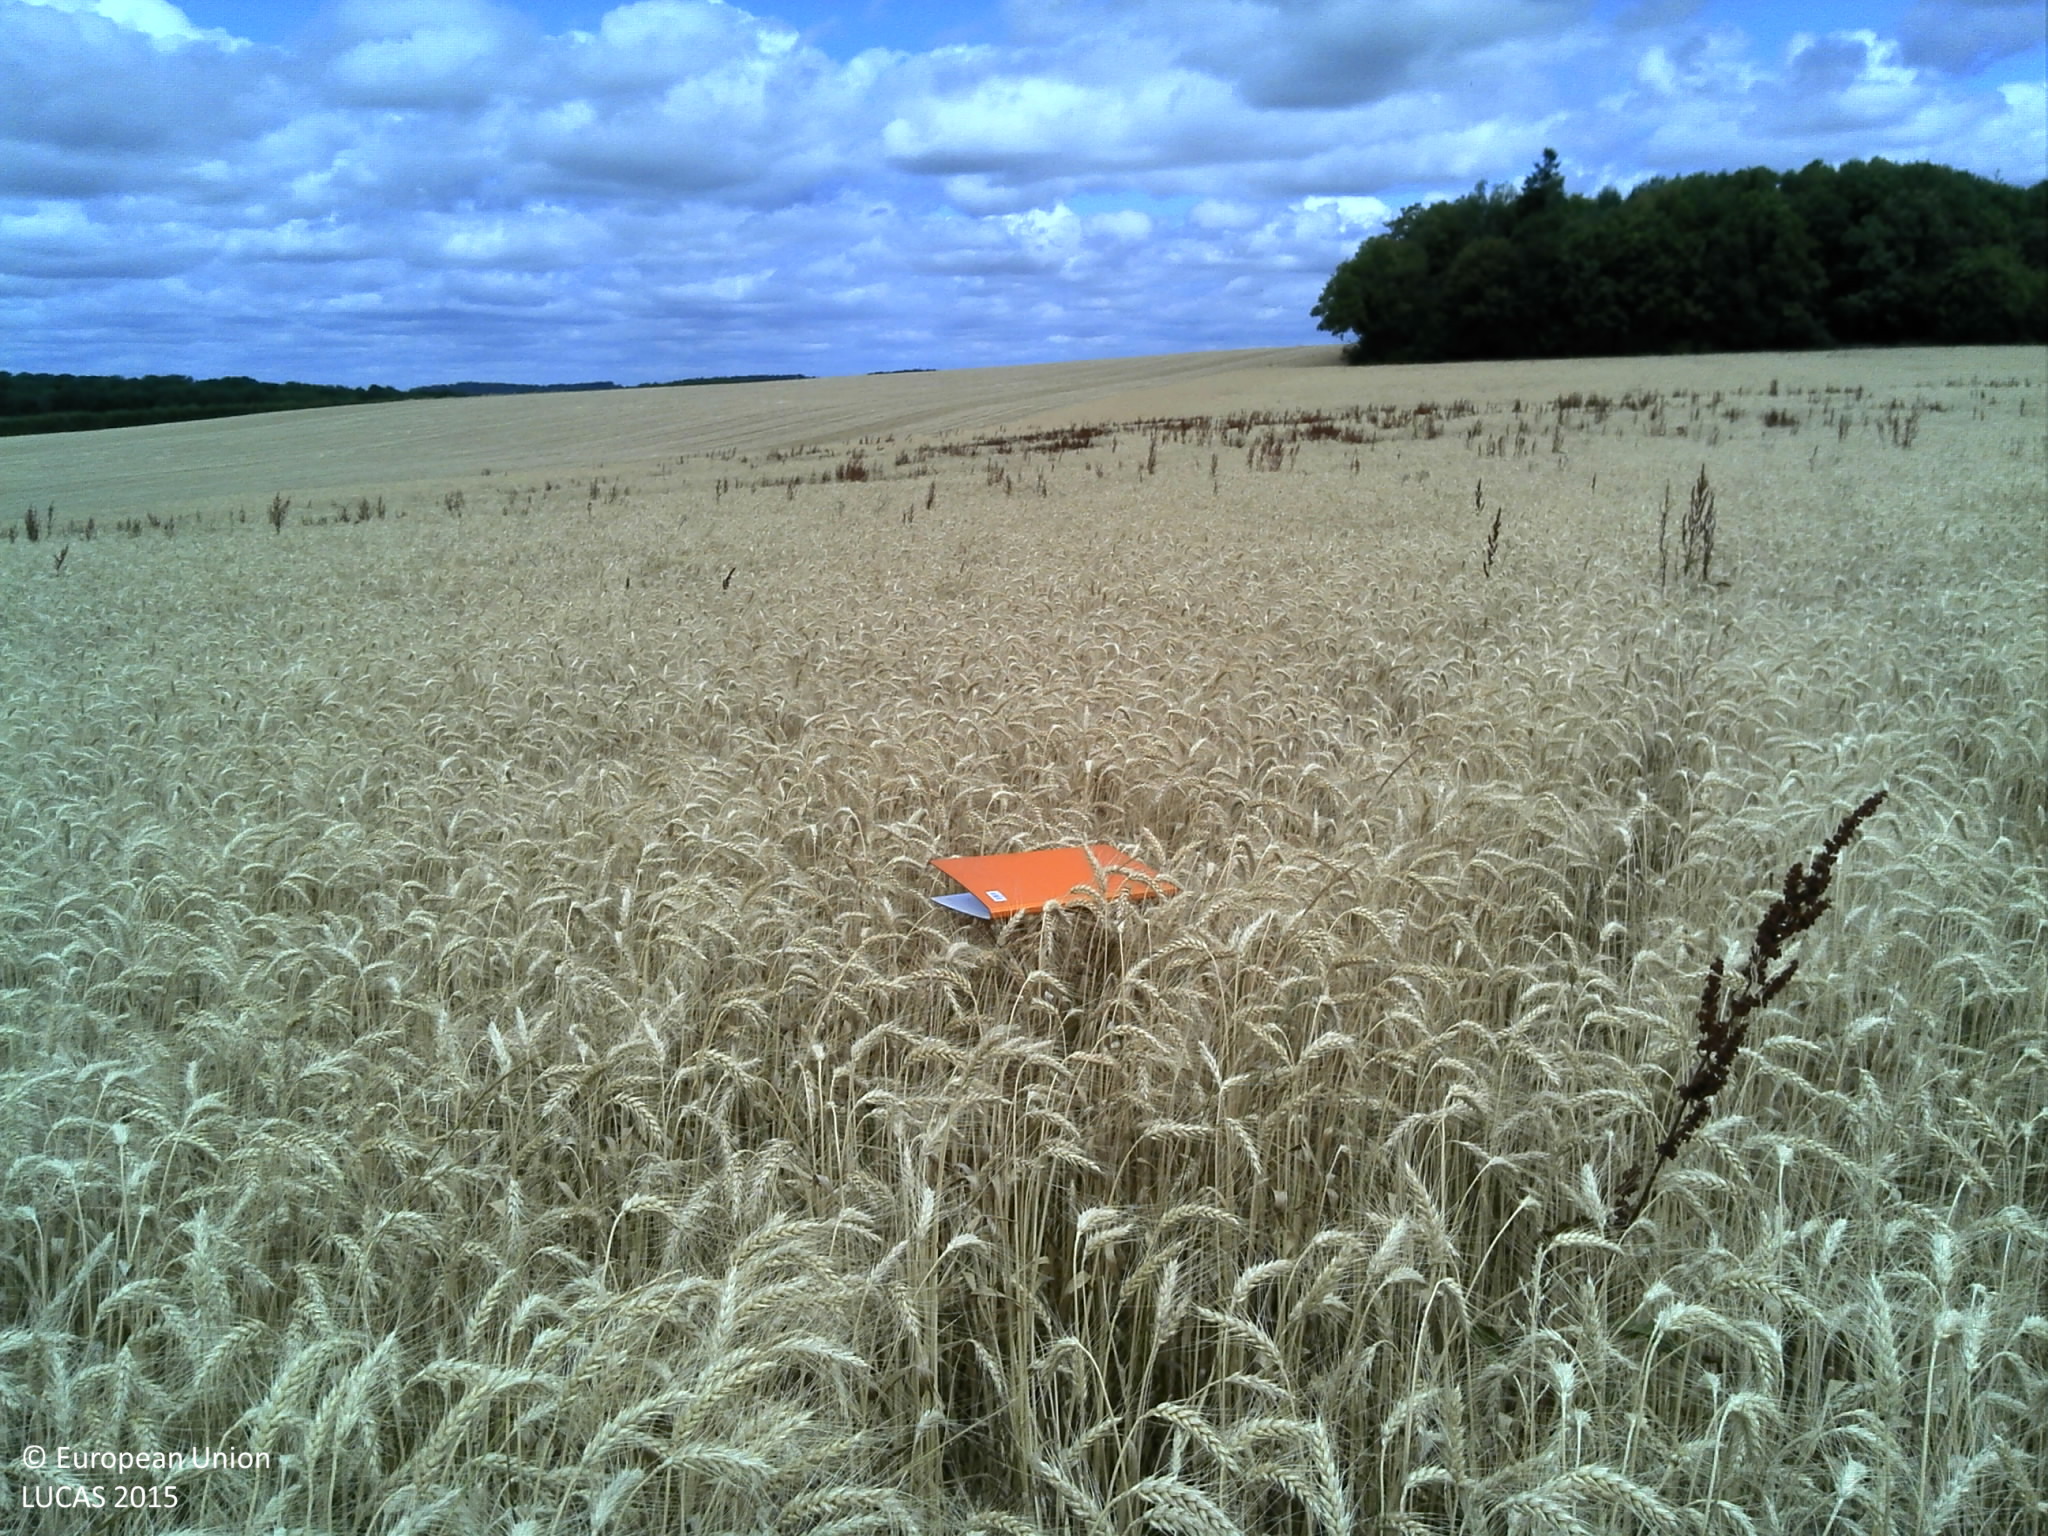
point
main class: Cropland
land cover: Durum wheat
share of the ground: > 75 %
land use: Agriculture (excluding fallow land and kitchen gardens)
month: July
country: FR
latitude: 48.1693
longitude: 6.0068
